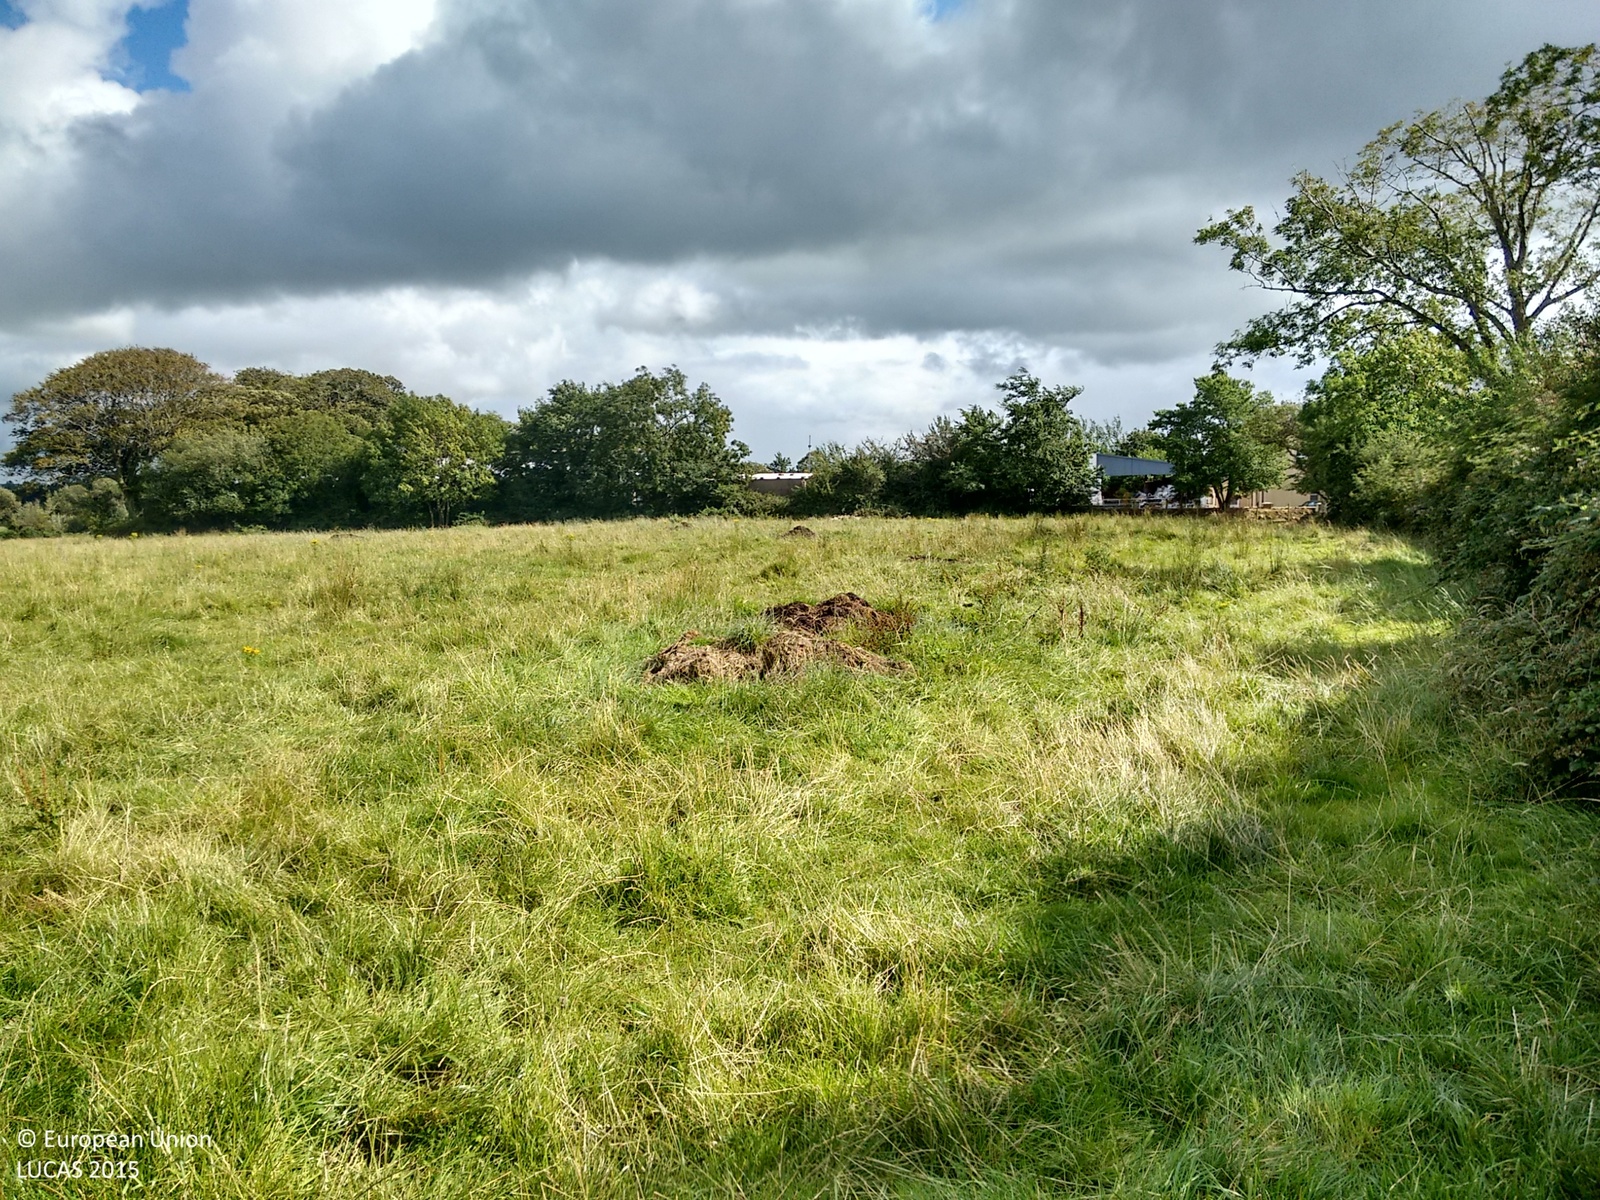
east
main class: Grassland
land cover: Grassland without tree/shrub cover
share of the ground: > 75 %
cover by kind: herbaceous plants 95 %, shrubs 5 %
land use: Agriculture (excluding fallow land and kitchen gardens)
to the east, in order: Grassland without tree/shrub cover; Fences; Broadleaved woodland; Inland fresh running water; Shrubland with sparse tree cover; Grassland without tree/shrub cover
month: August
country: IE
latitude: 52.1836
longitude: -9.7087
